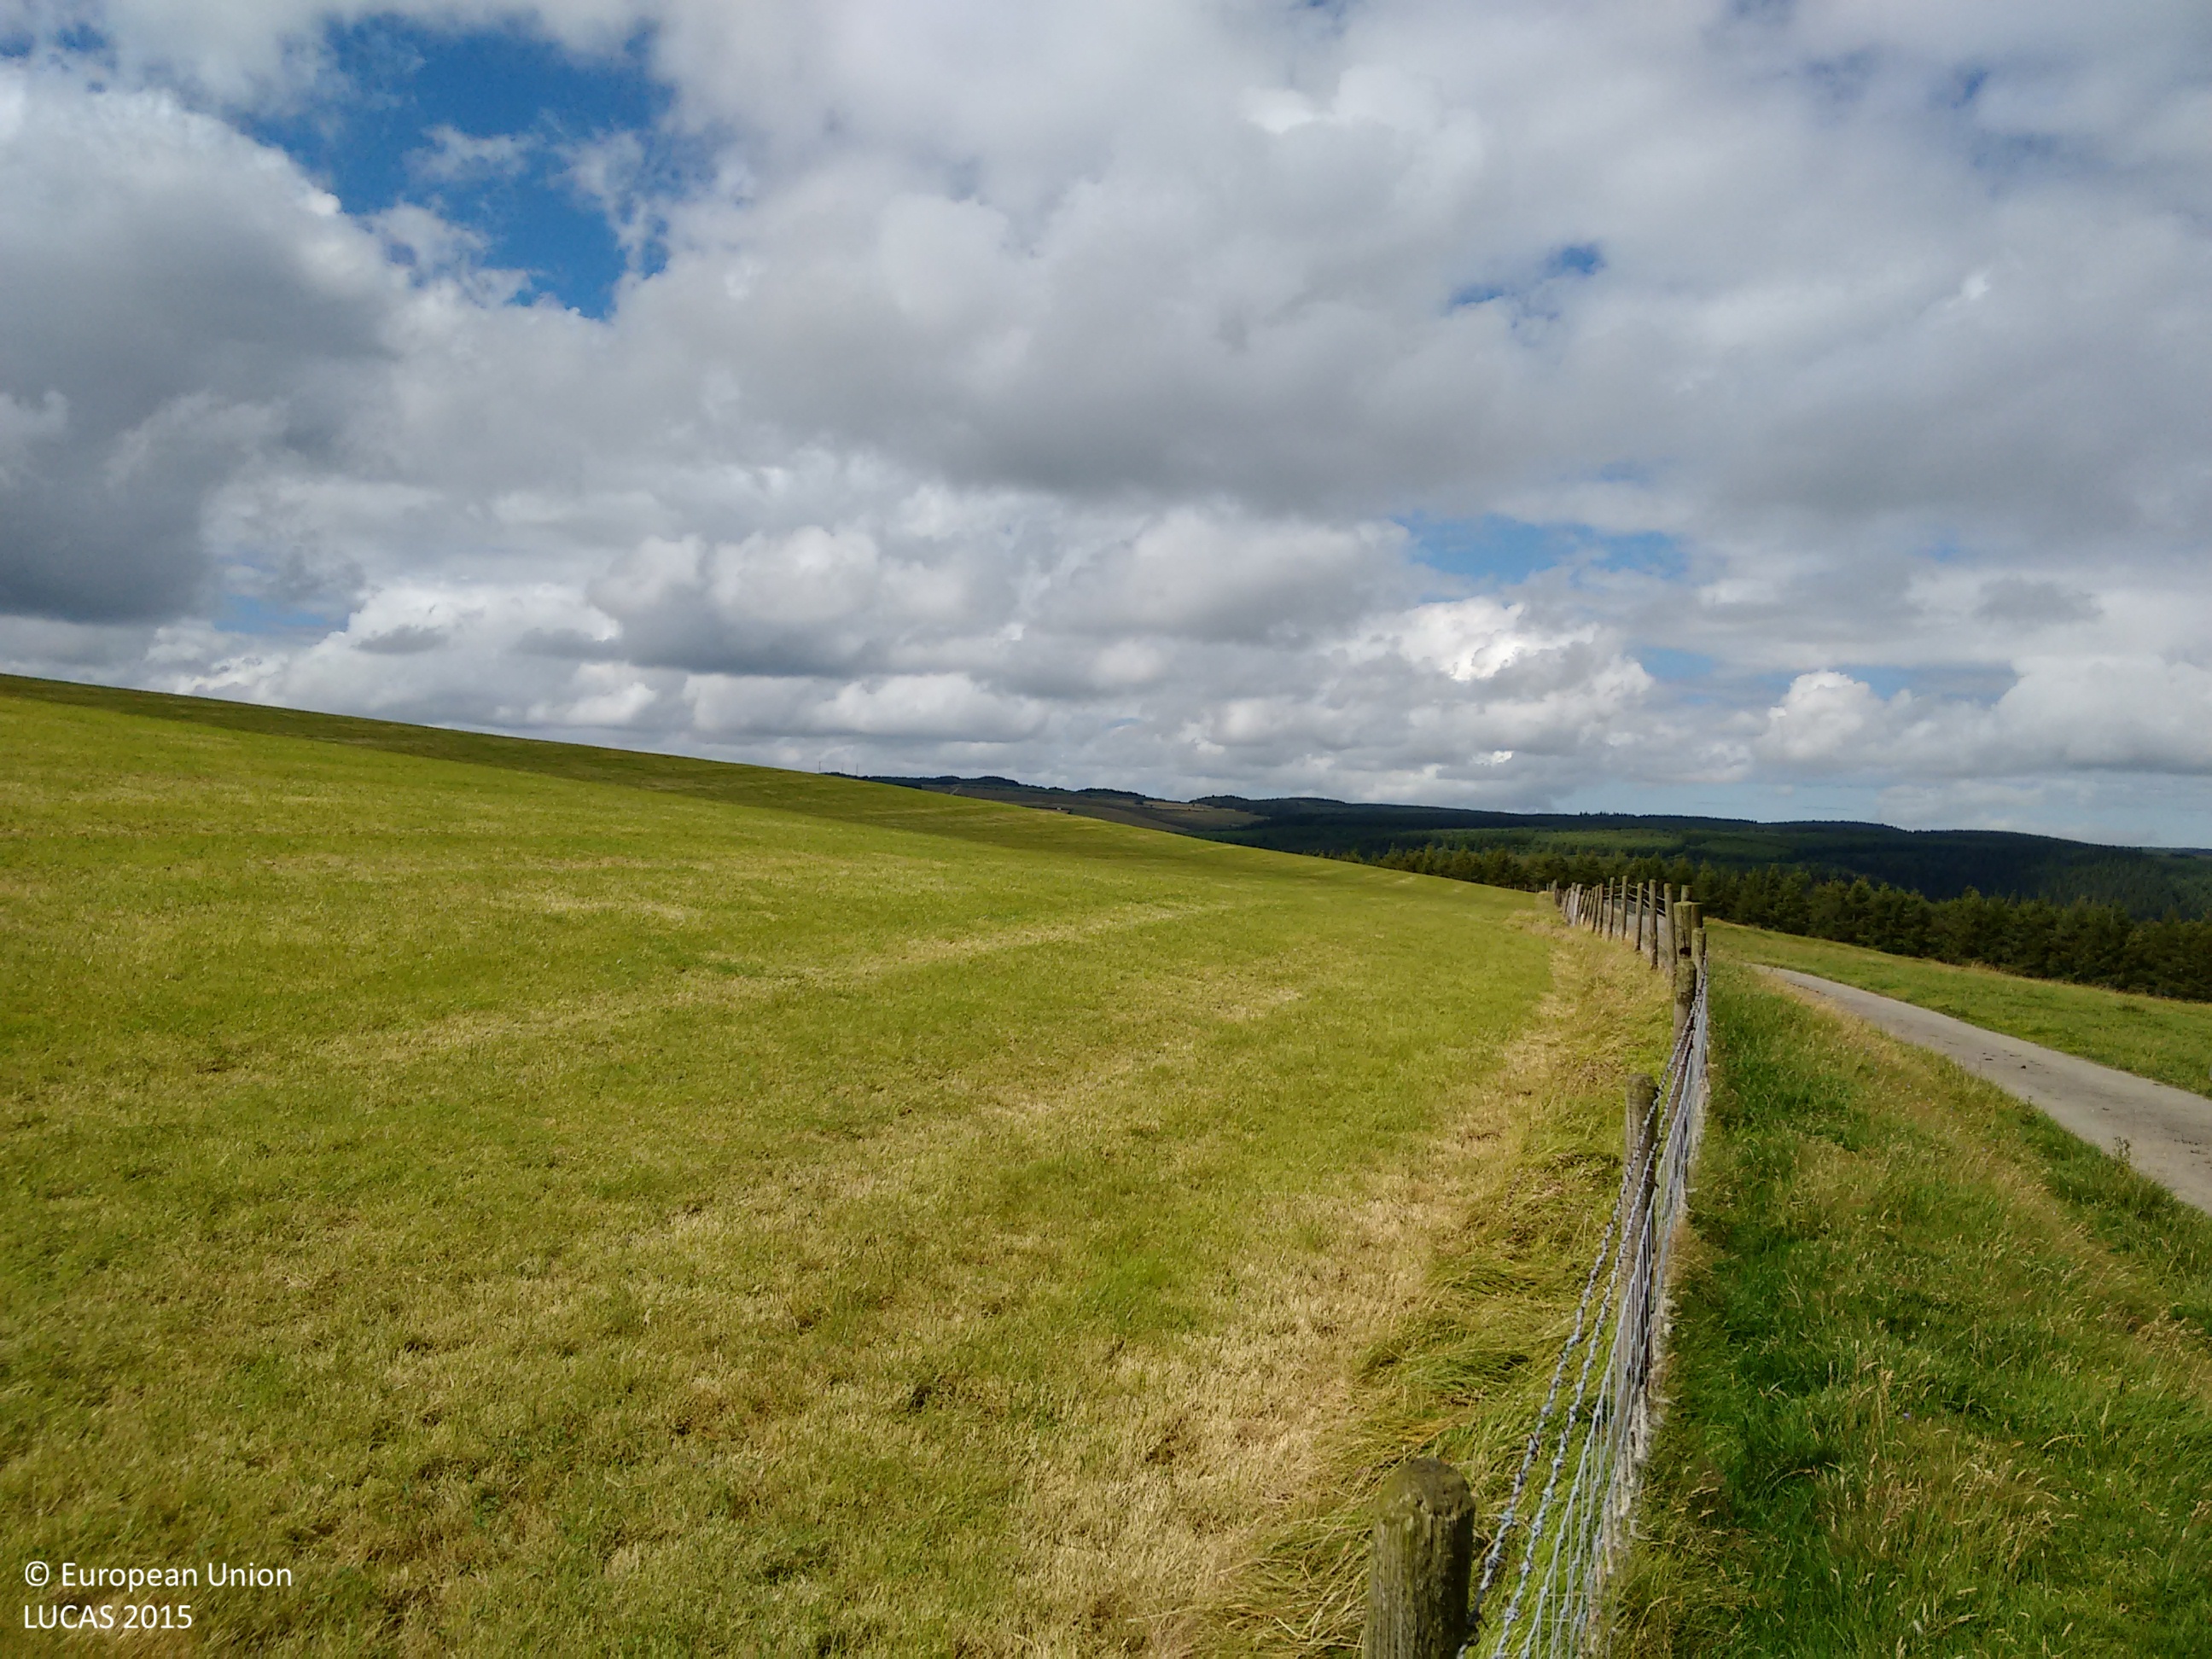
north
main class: Grassland
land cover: Grassland without tree/shrub cover
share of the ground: > 75 %
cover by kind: herbaceous plants 100 %
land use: Agriculture (excluding fallow land and kitchen gardens)
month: August
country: GB
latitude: 52.0055
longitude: -4.0961
